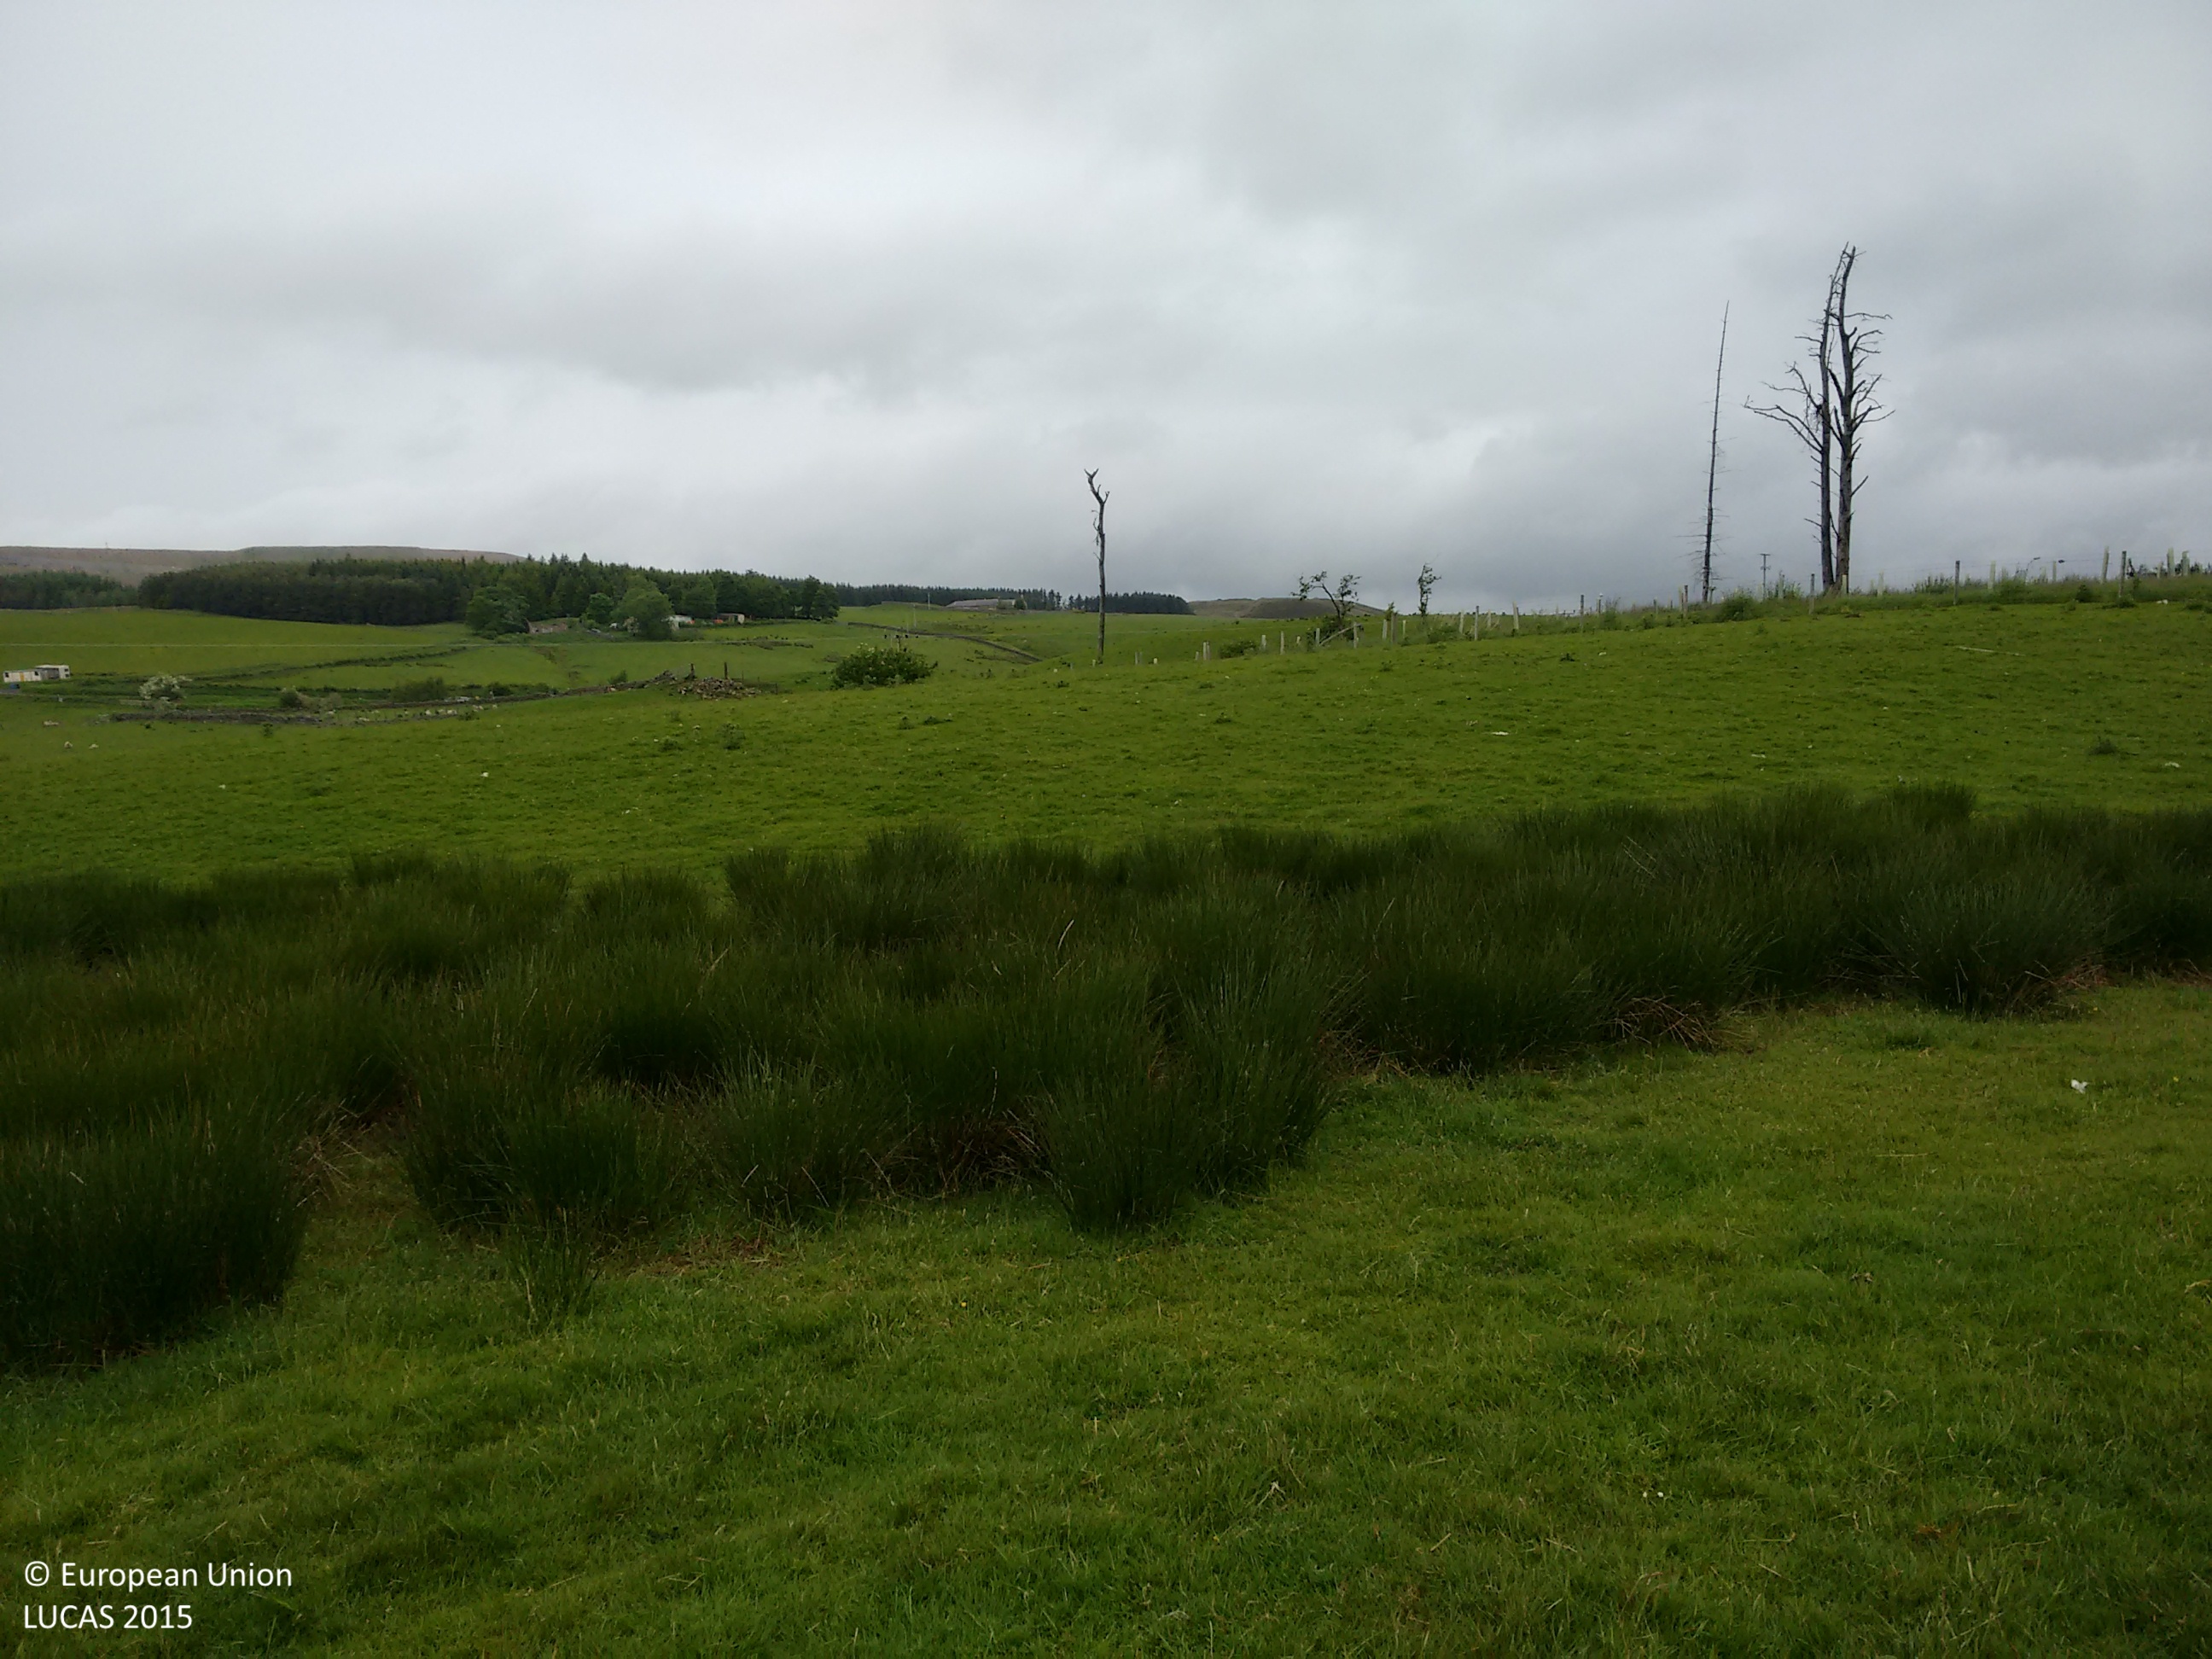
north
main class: Grassland
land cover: Grassland without tree/shrub cover
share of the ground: 50 - 75 %
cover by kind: herbaceous plants 100 %
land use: Agriculture (excluding fallow land and kitchen gardens)
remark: Clear cut
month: June
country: GB
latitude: 55.6002
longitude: -3.8134
